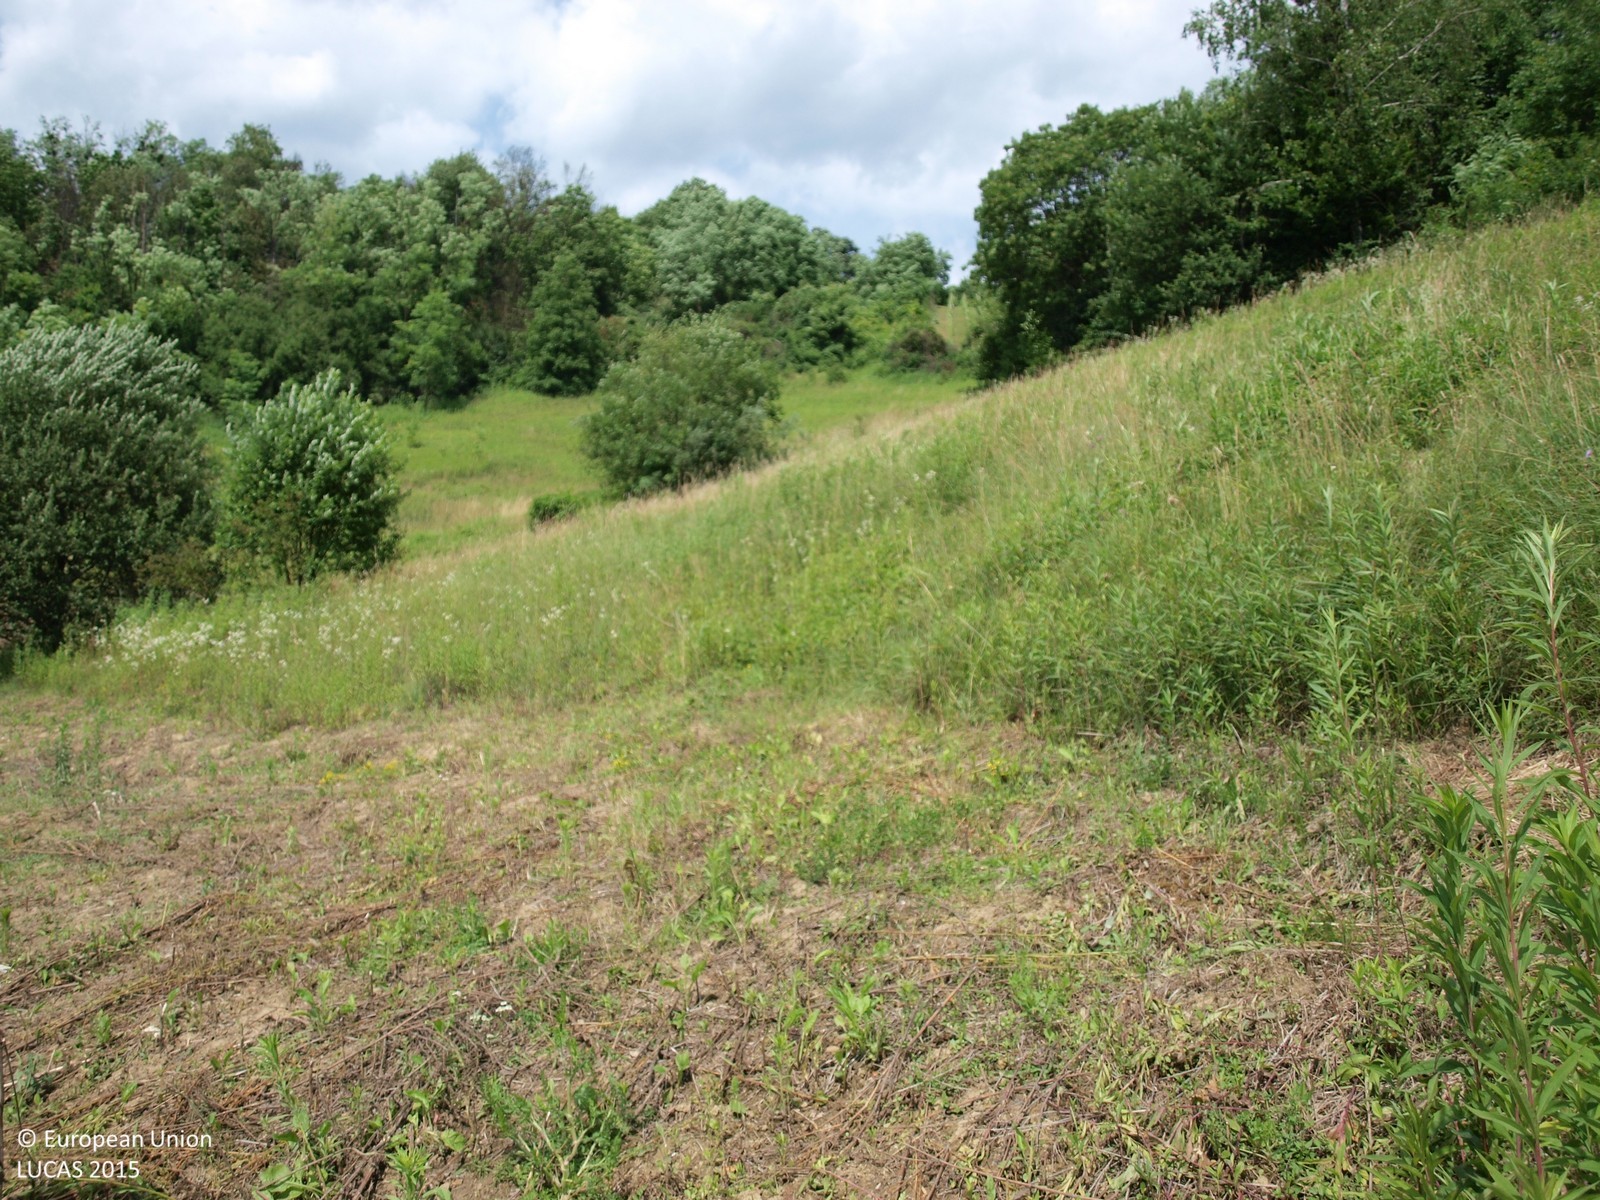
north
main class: Grassland
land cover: Grassland without tree/shrub cover
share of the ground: > 75 %
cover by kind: herbaceous plants 100 %
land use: Agriculture (excluding fallow land and kitchen gardens)
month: June
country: HR
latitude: 46.1446
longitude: 15.7075
